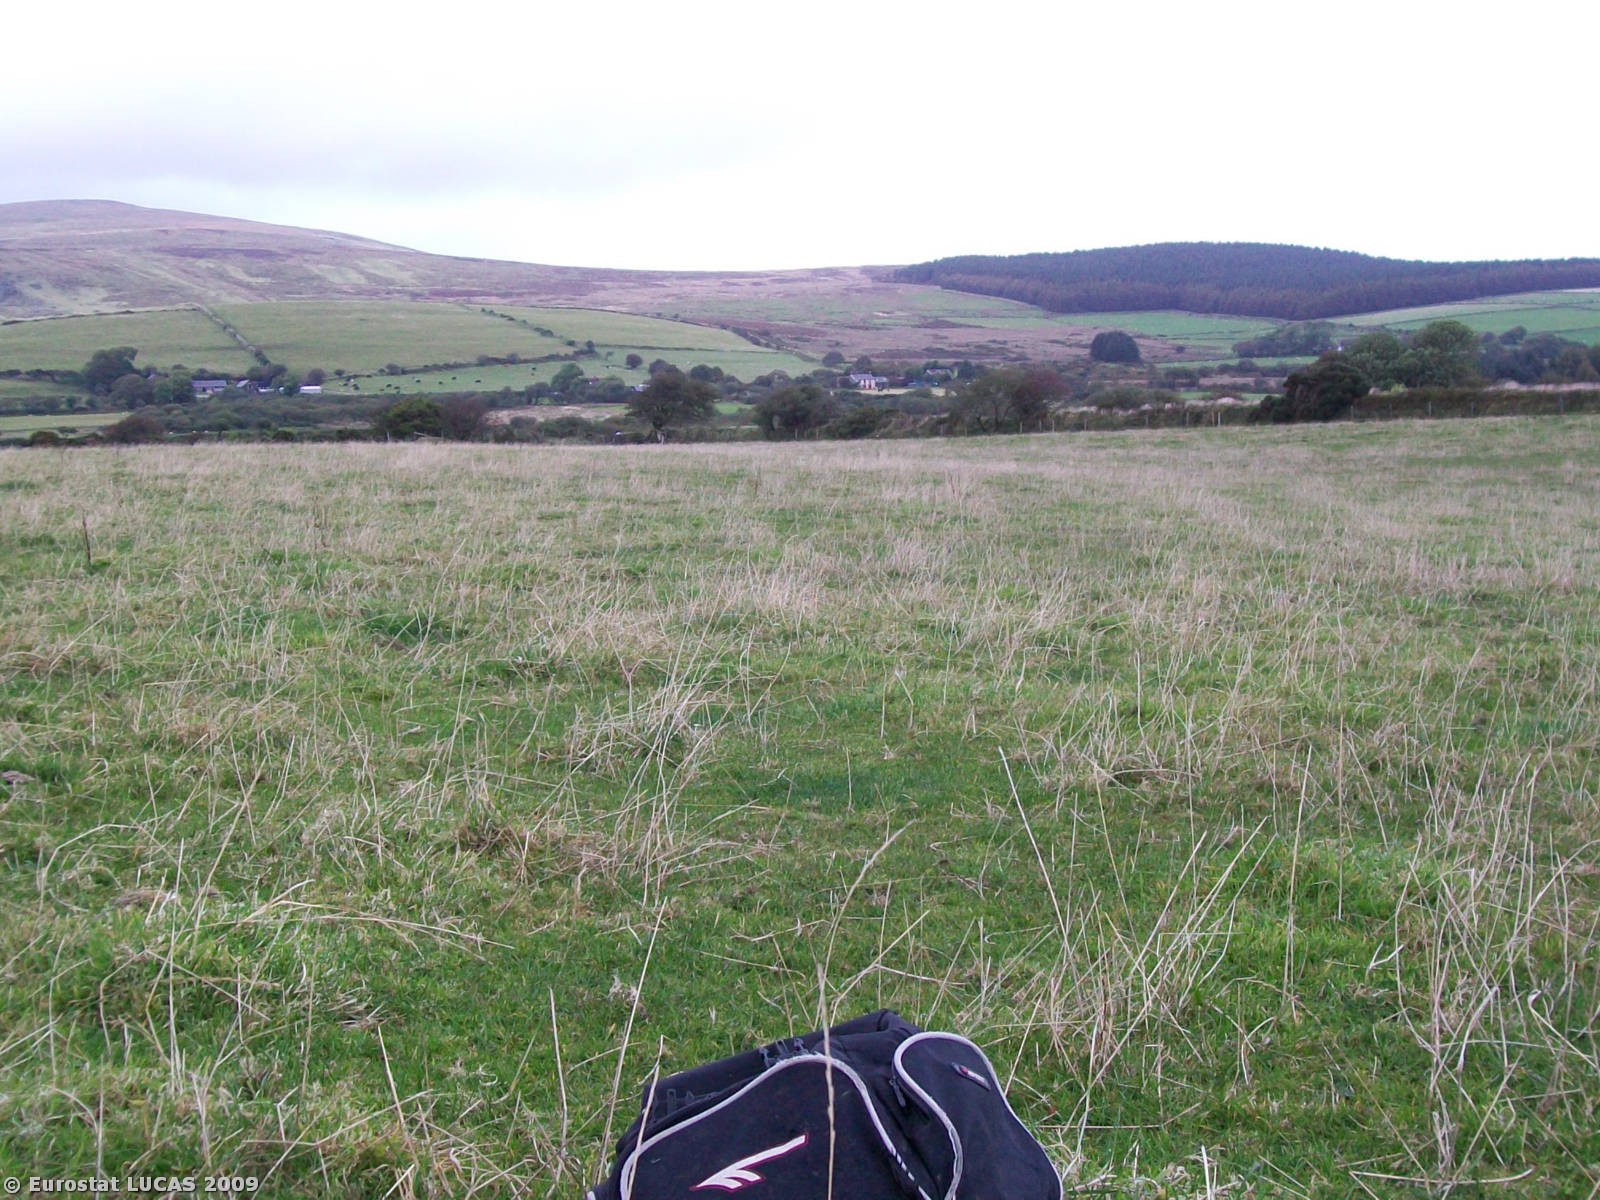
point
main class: Grassland
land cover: Grassland without tree/shrub cover
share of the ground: > 75 %
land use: Agriculture (excluding fallow land and kitchen gardens)
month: September
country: GB
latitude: 51.9204
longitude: -4.7828
